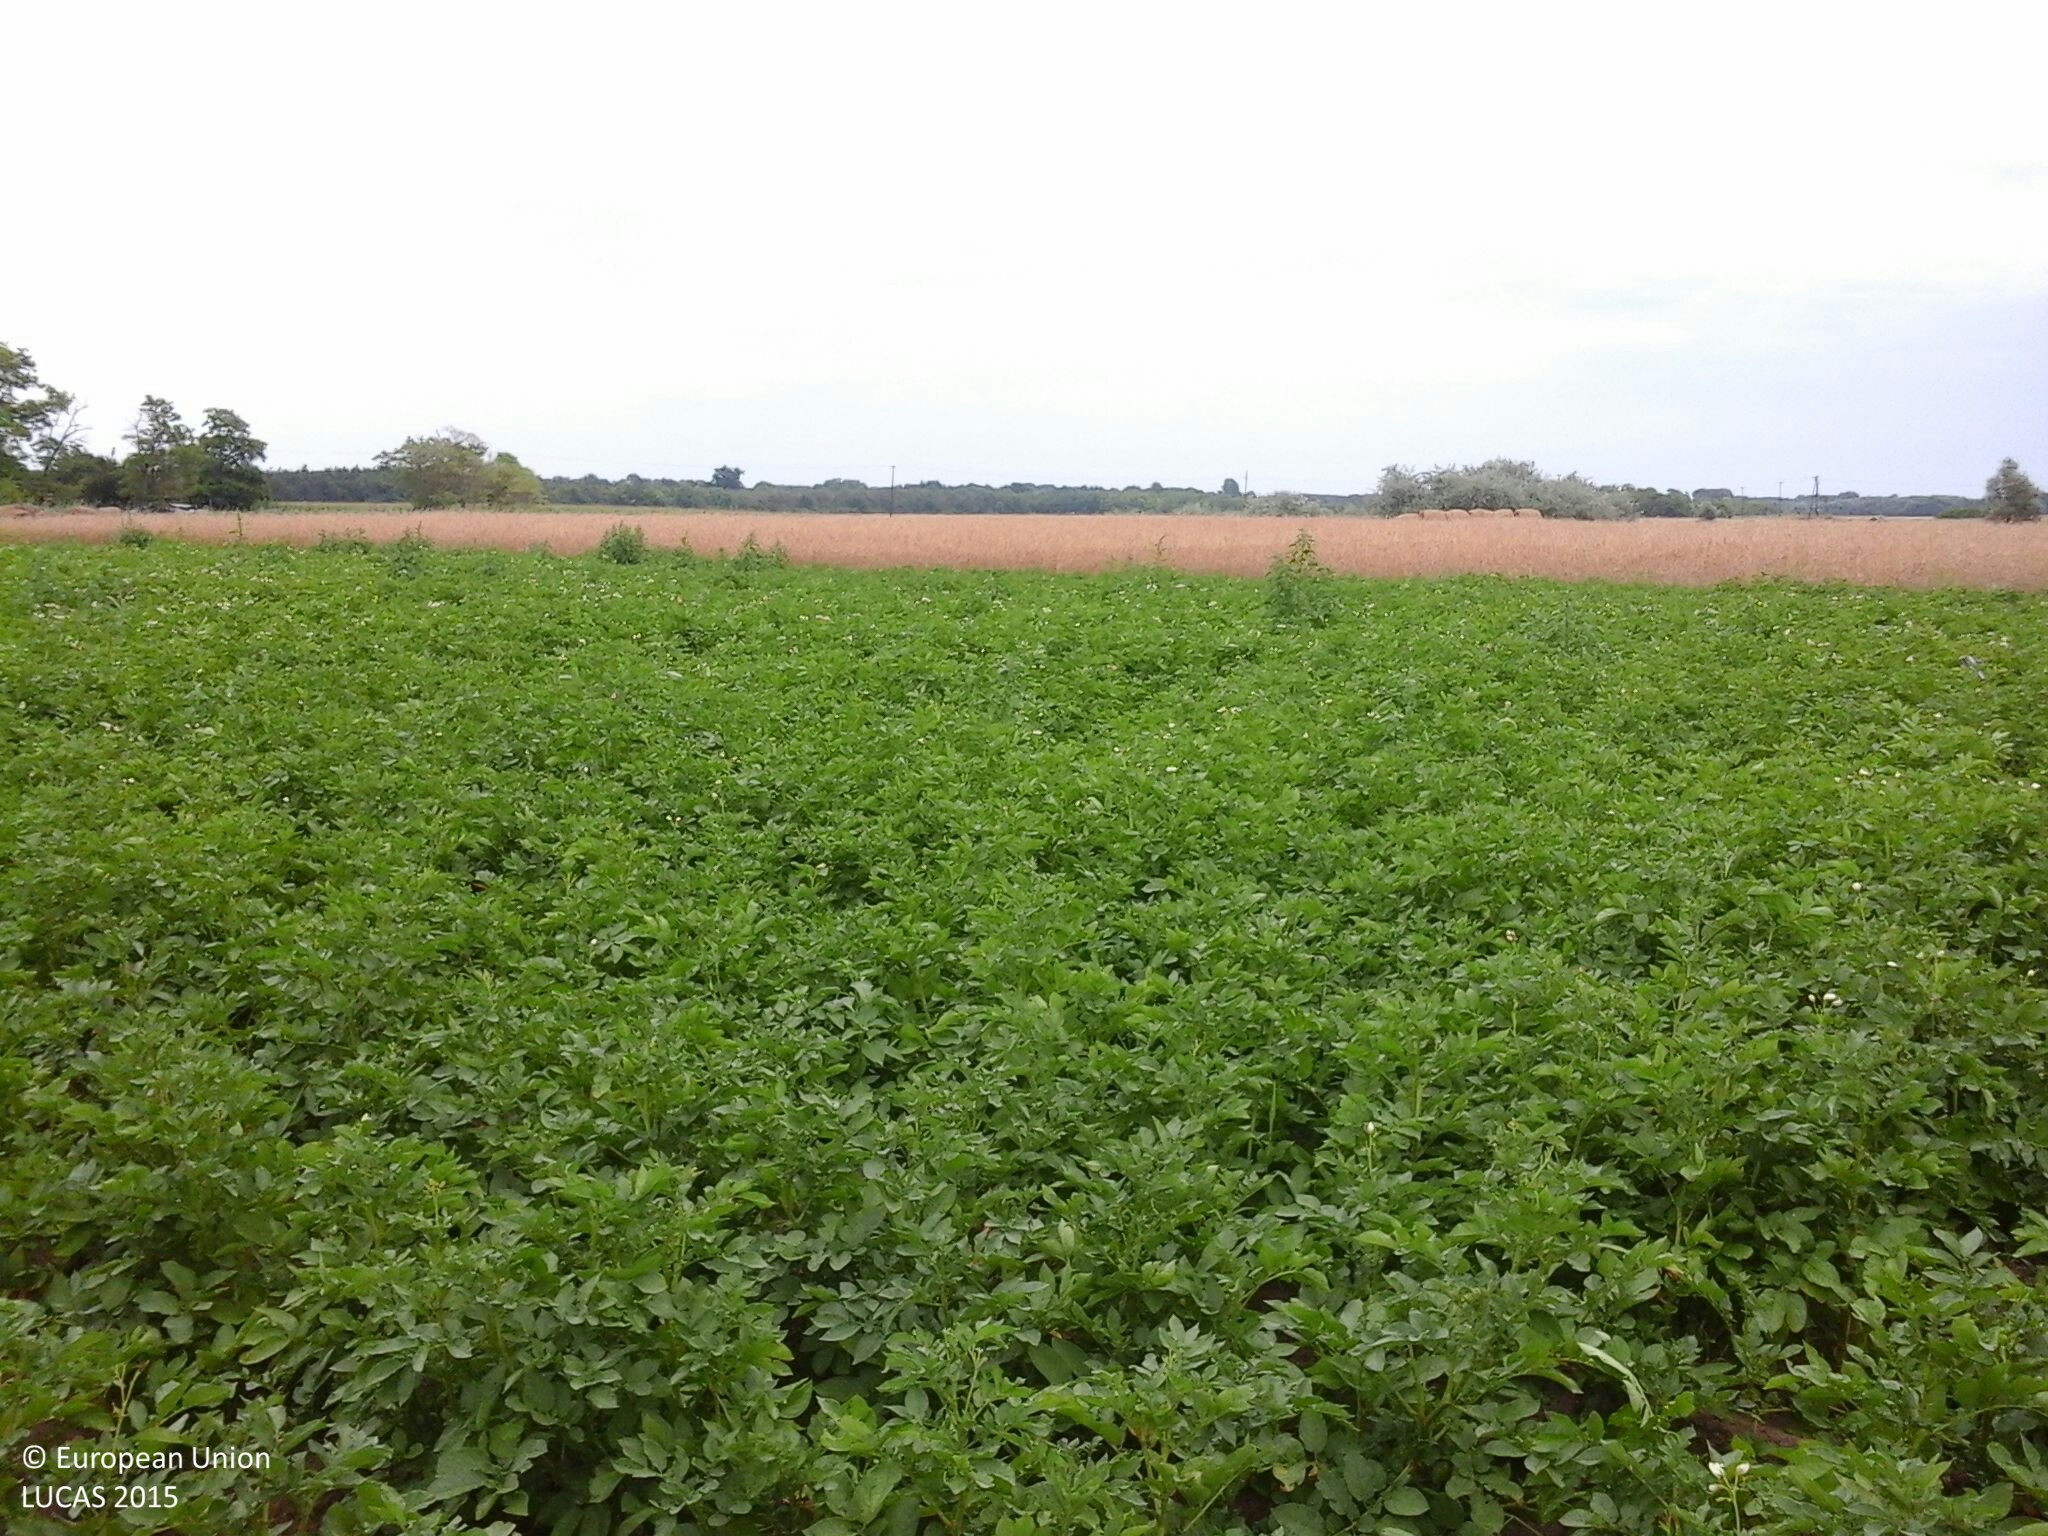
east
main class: Cropland
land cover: Potatoes
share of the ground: > 75 %
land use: Agriculture (excluding fallow land and kitchen gardens)
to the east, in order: Potatoes; Triticale; Grassland without tree/shrub cover; Ditches and canals; Grassland without tree/shrub cover; Spontaneously vegetated surfaces; Maize
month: July
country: HU
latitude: 46.4766
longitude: 20.0379
